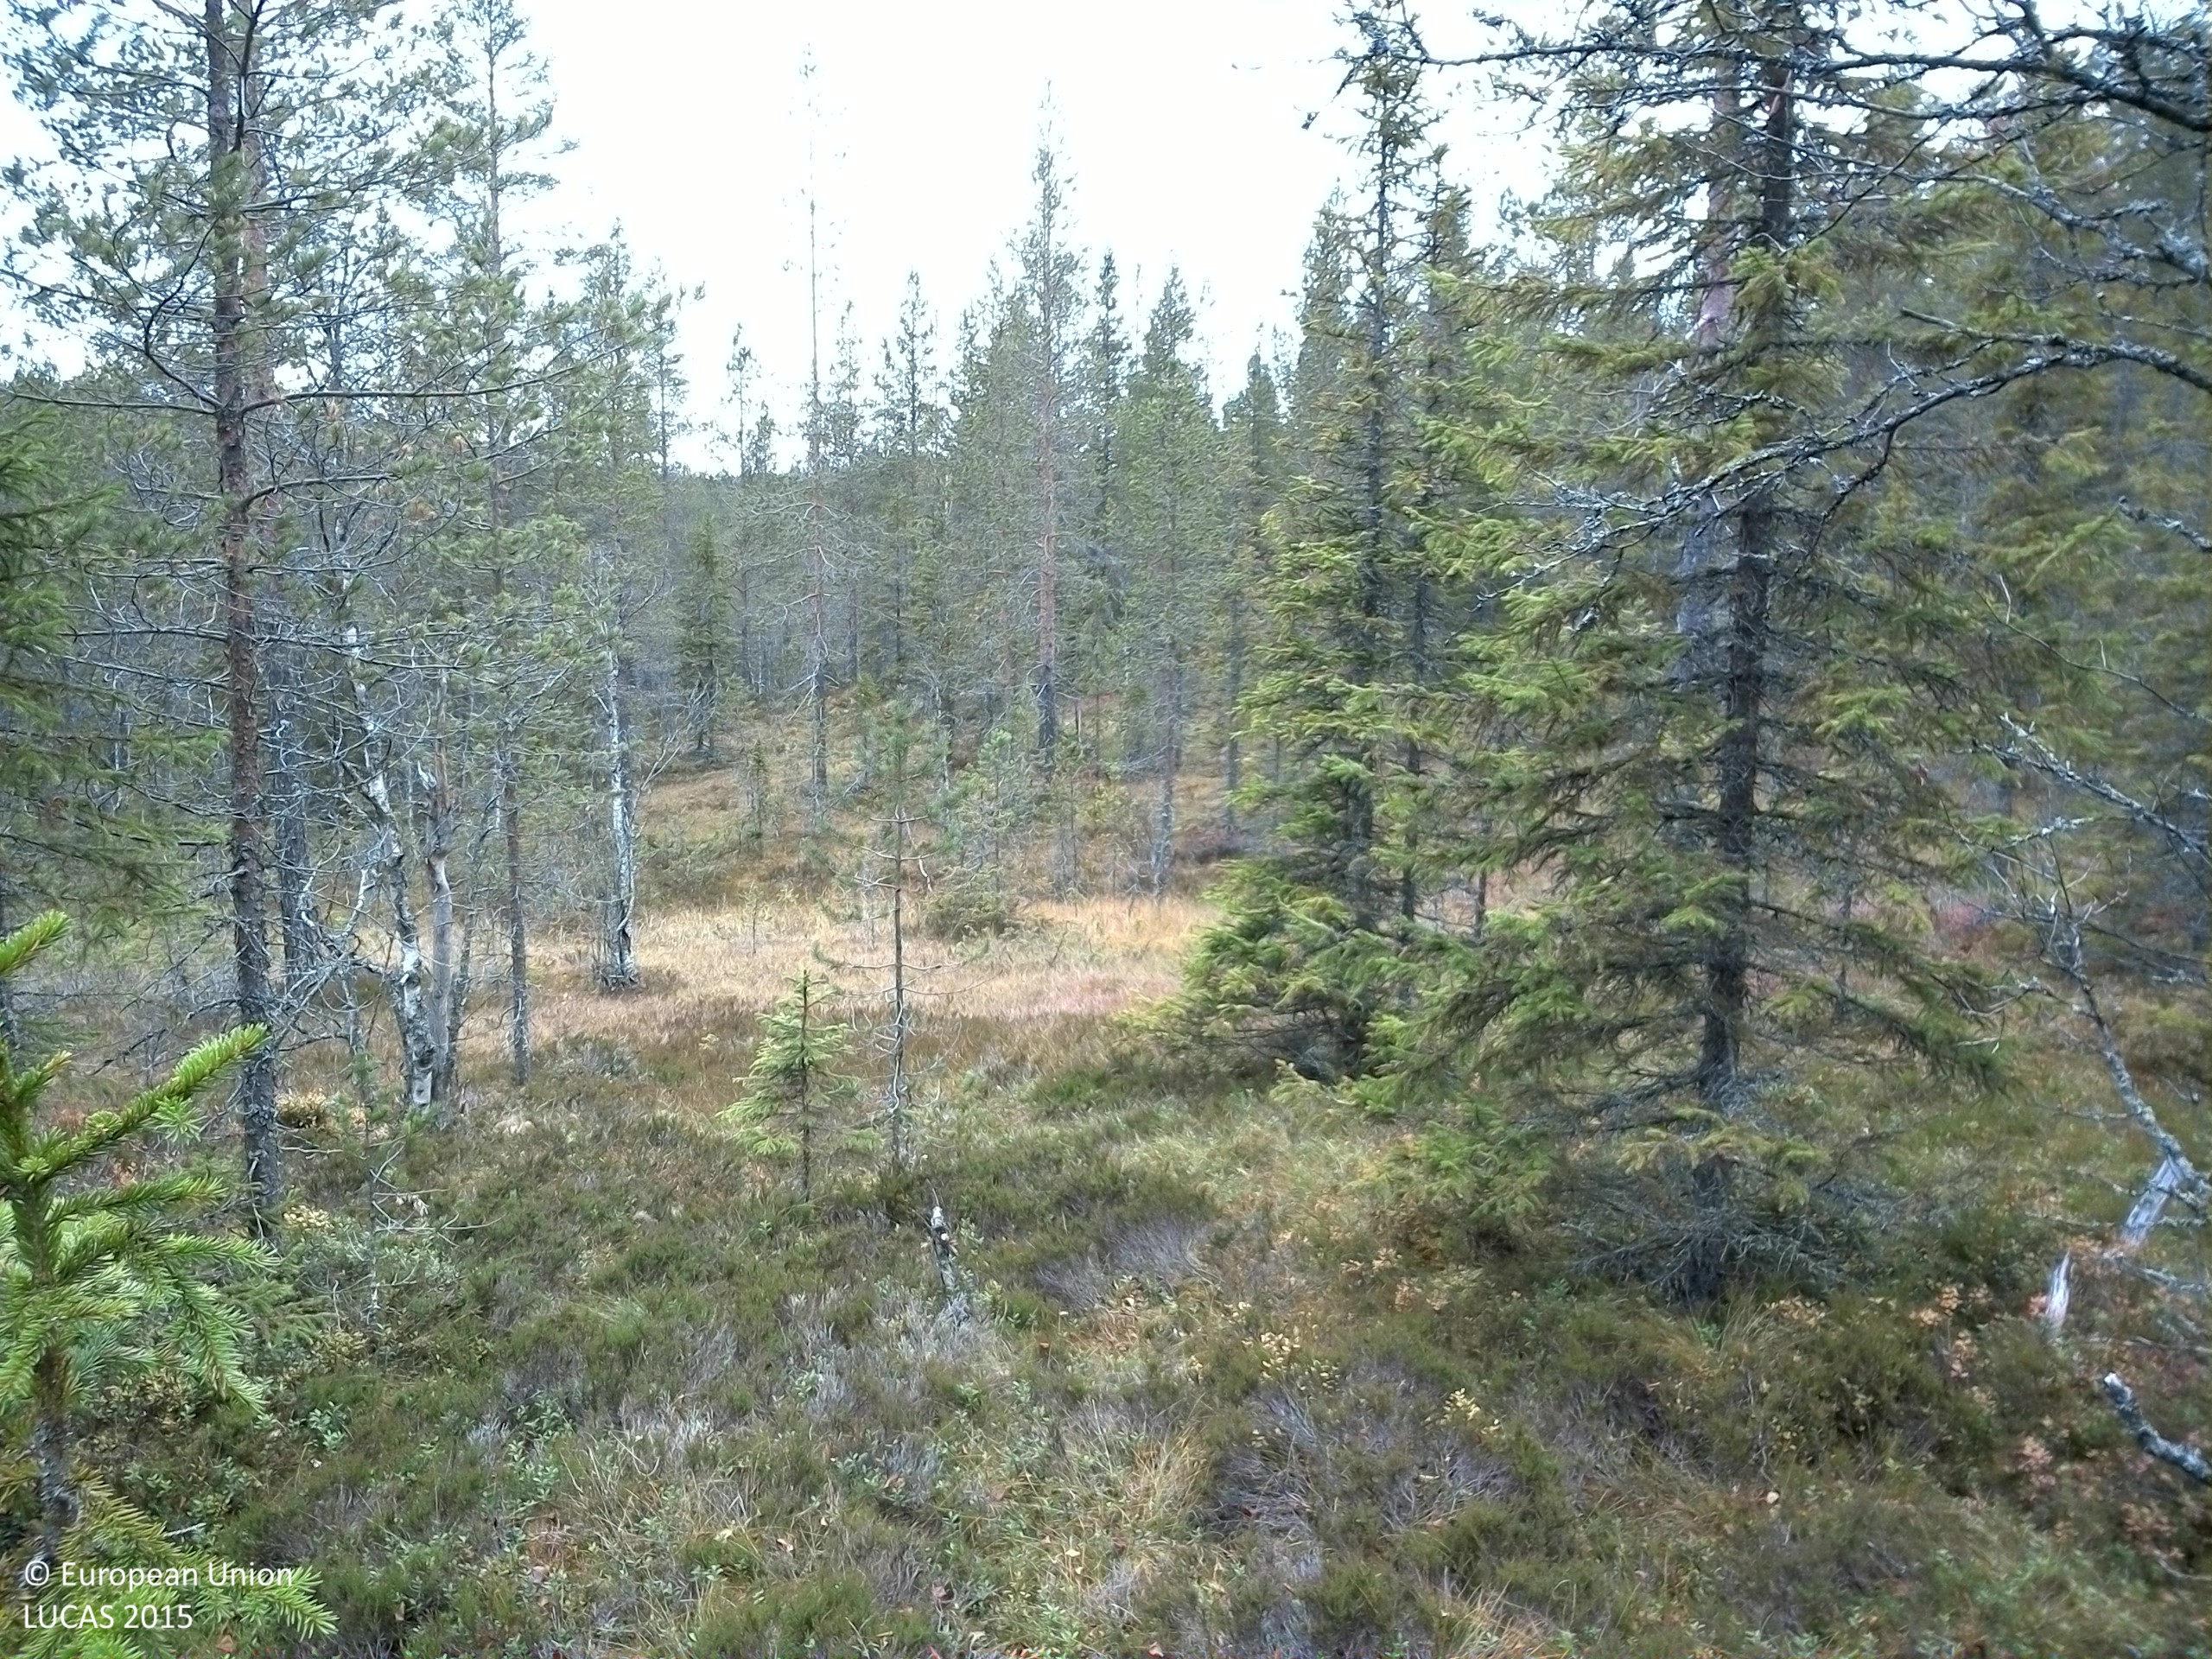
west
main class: Woodland
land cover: Spruce dominated mixed woodland
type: boreal forest
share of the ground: 25 - 50 %
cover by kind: shrubs 35 %, coniferous forest trees 30 %, lichens and mosses 20 %, broadleaved forest trees 15 %
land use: Forestry
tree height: > 5 m
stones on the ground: < 10 %
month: October
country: SE
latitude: 61.4291
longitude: 14.3904
